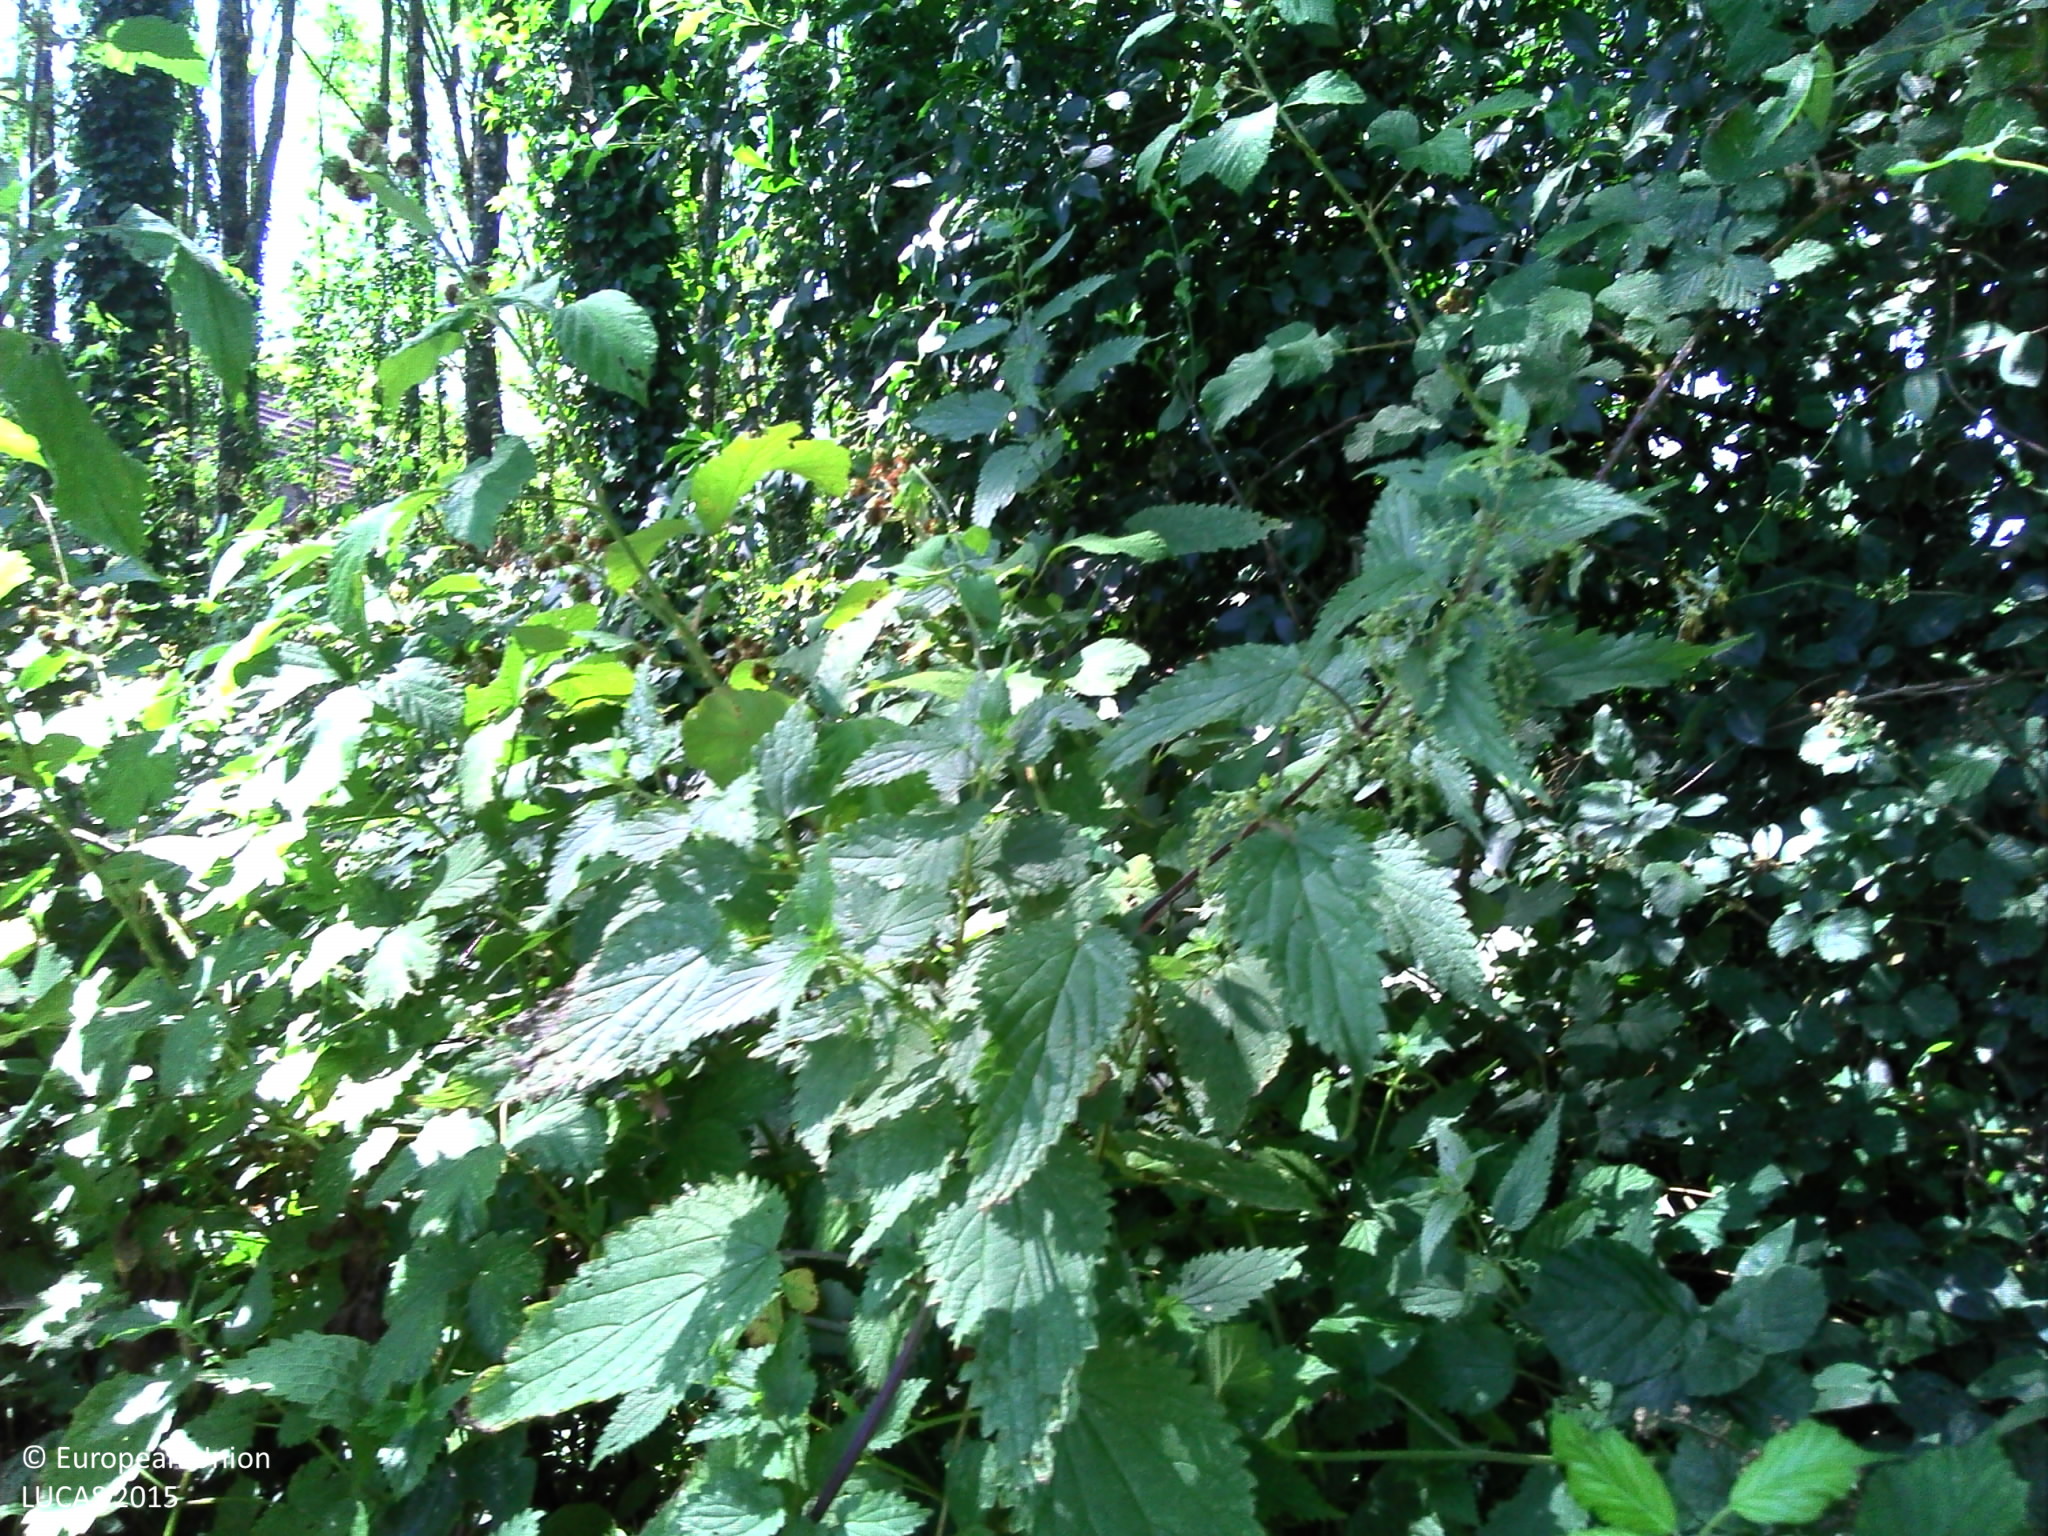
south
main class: Woodland
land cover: Broadleaved woodland
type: thermophilous deciduous forest
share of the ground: > 75 %
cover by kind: broadleaved forest trees 80 %, shrubs 20 %
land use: Forestry
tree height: > 5 m
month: June
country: FR
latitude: 46.6858
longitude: 5.4129
